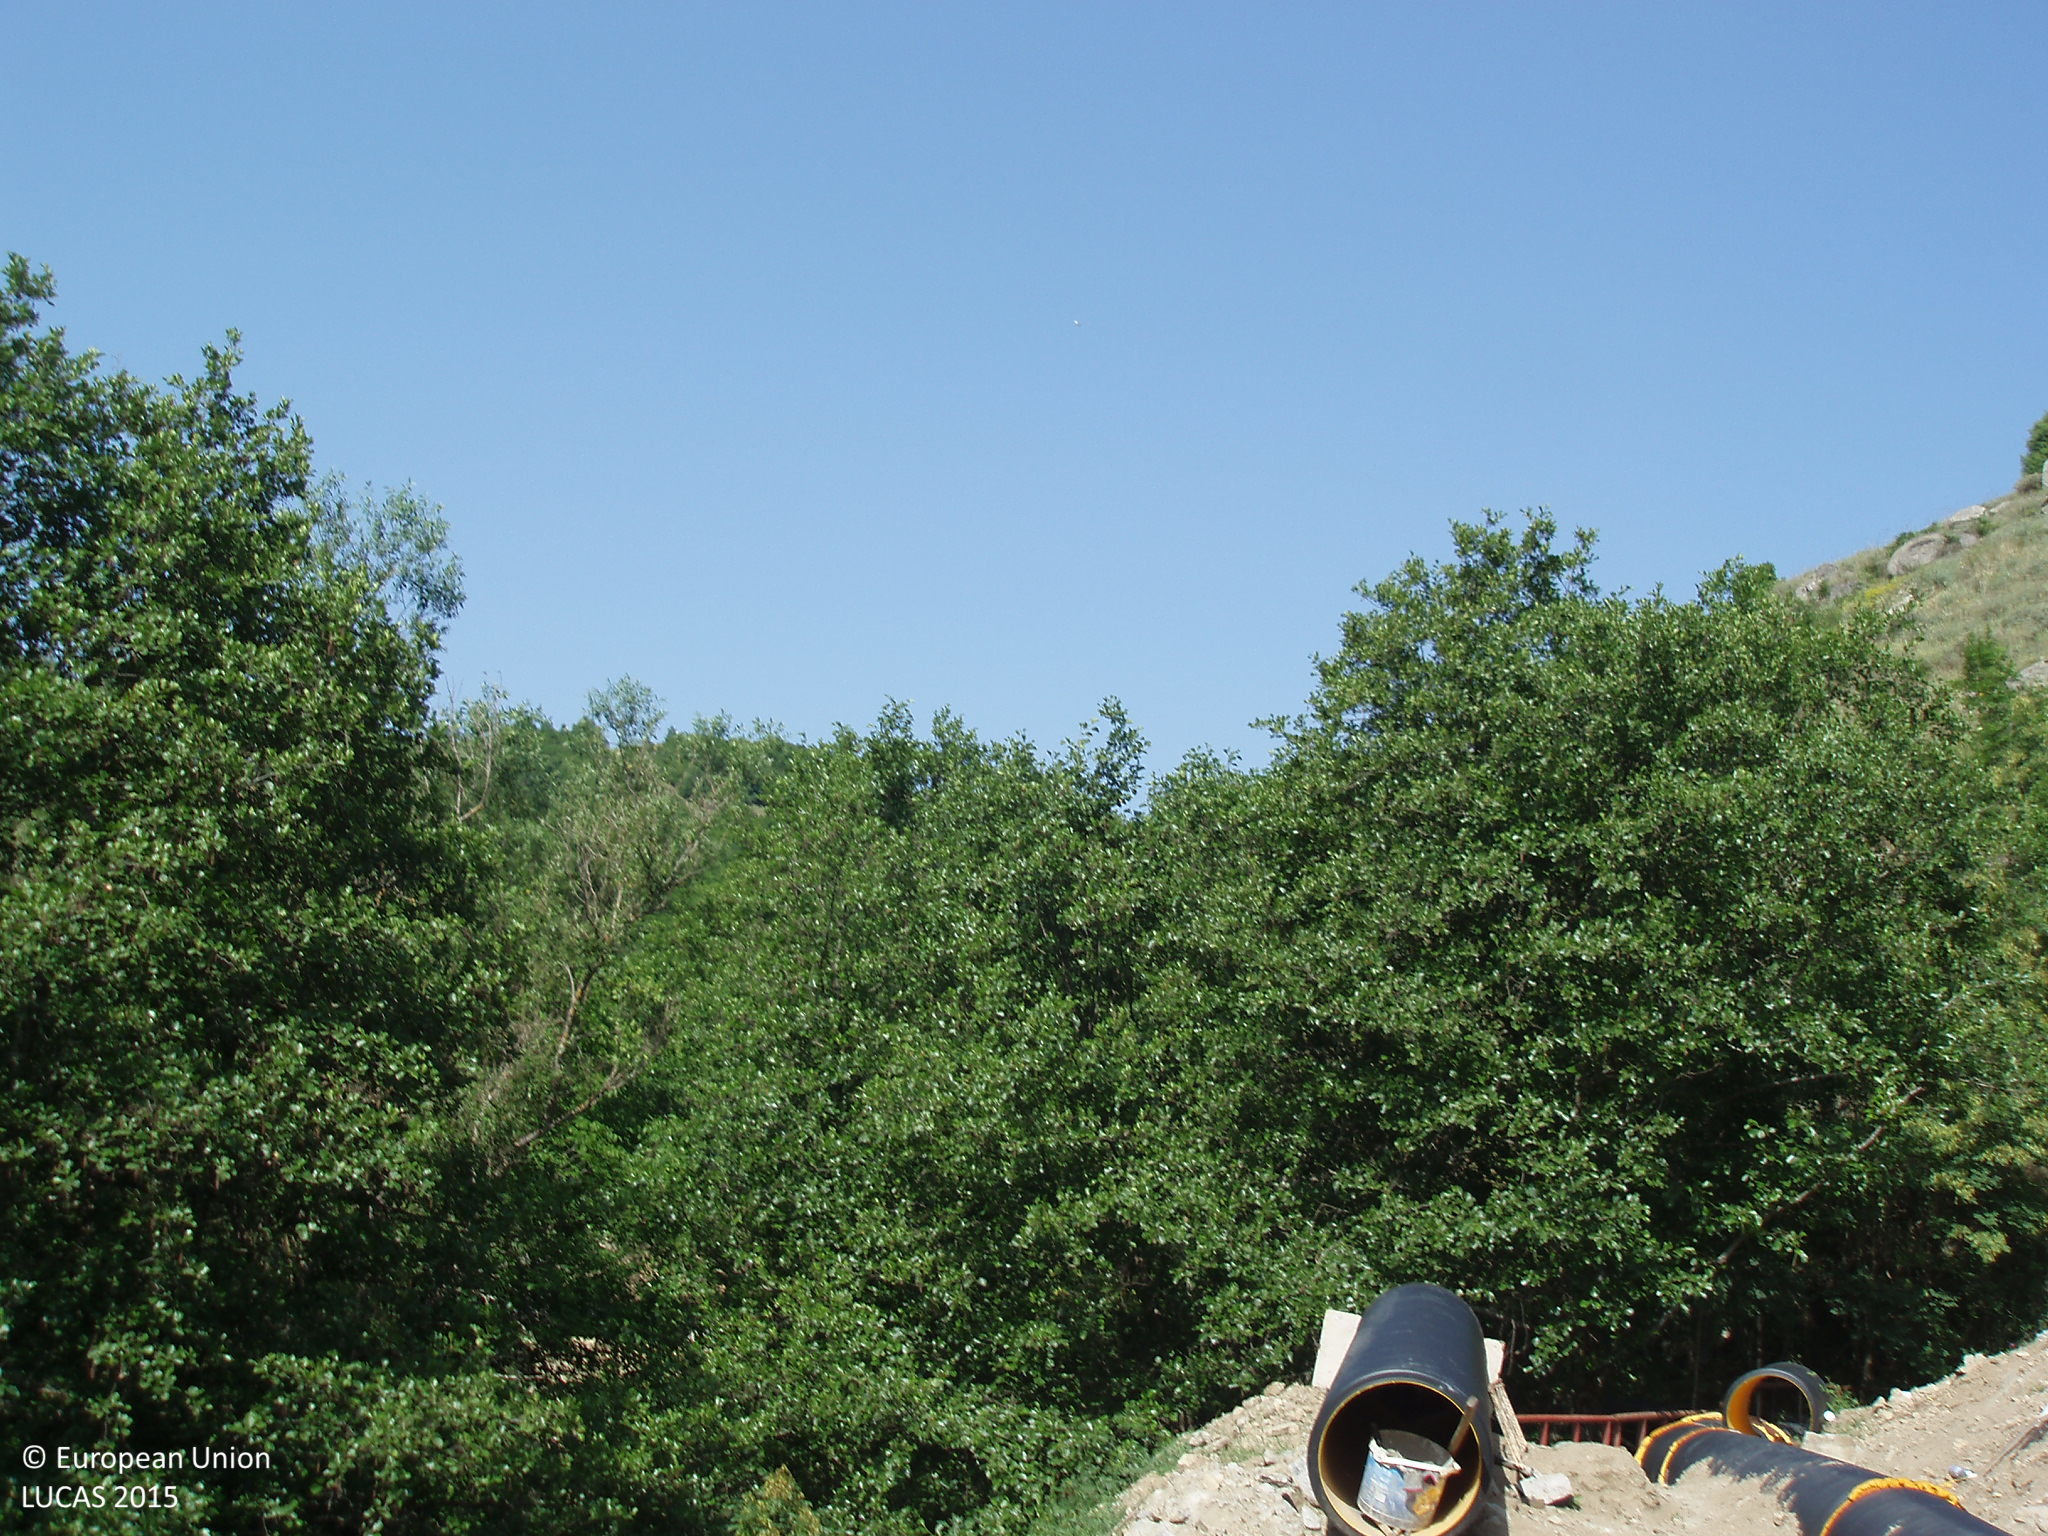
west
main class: Woodland
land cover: Pine dominated mixed woodland
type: hemiboreal forest and nemoral coniferous forest and mixed broadleaved-coniferous forest
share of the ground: > 75 %
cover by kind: coniferous forest trees 75 %, broadleaved forest trees 25 %
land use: Forestry
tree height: > 5 m
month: June
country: BG
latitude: 41.4605
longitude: 23.7109
